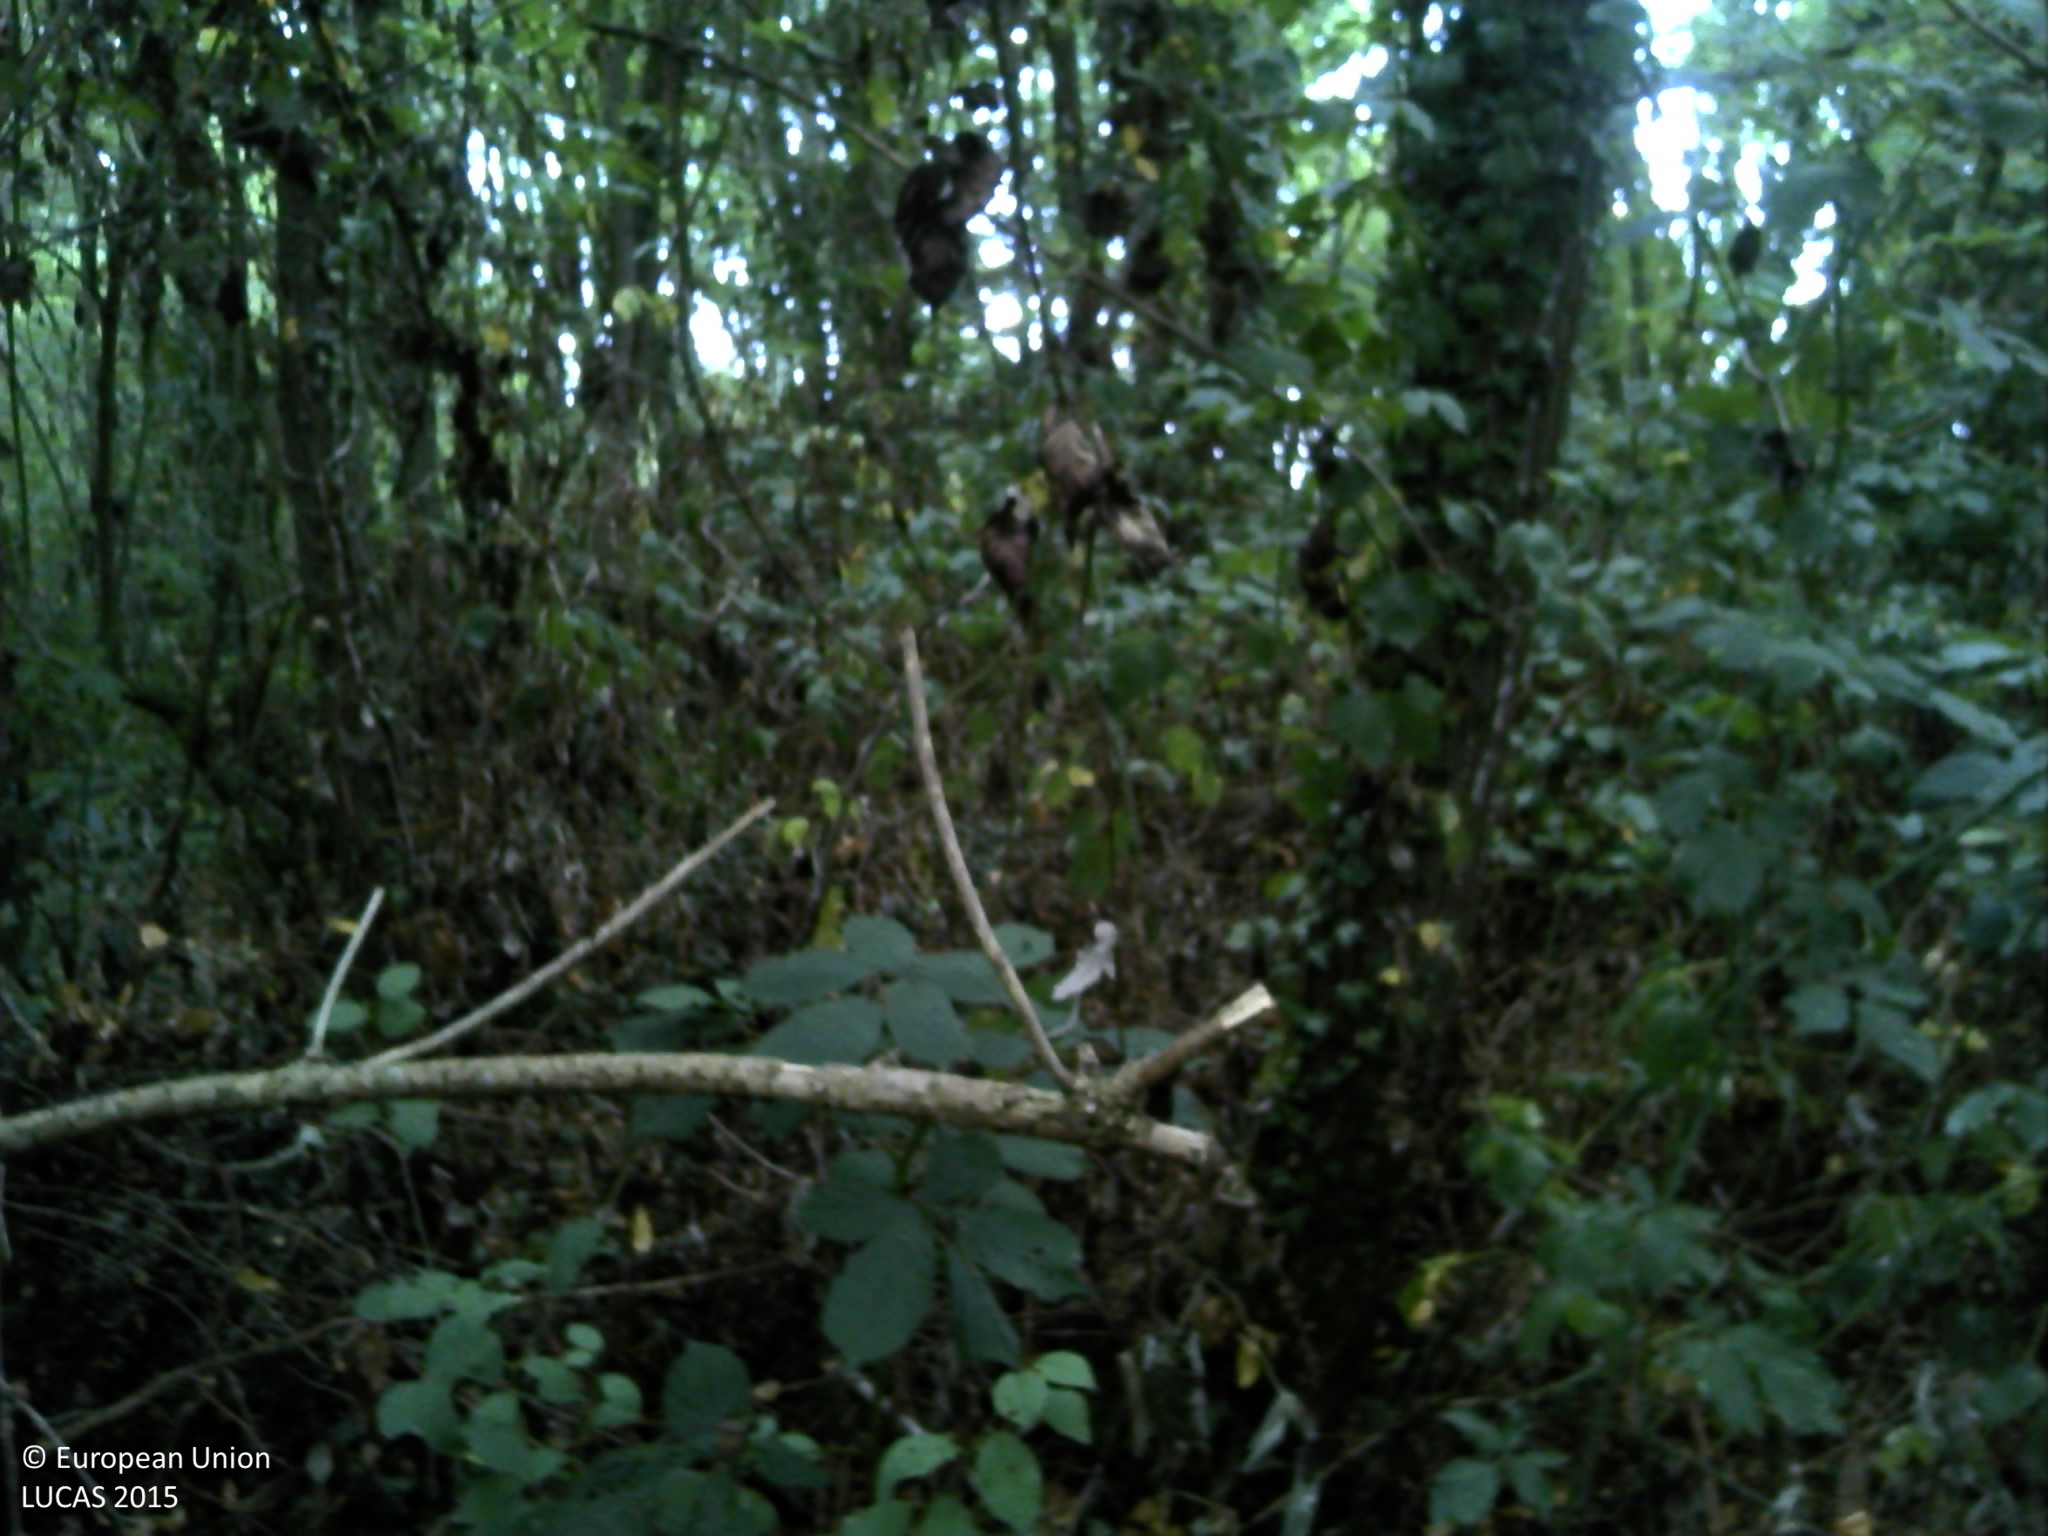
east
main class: Woodland
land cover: Broadleaved woodland
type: acidophilous oak and oak-birch forest
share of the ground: > 75 %
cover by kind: broadleaved forest trees 60 %, shrubs 30 %, herbaceous plants 5 %, lichens and mosses 5 %
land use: Semi-natural and natural areas not in use
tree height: > 5 m
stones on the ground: 10 - 25 %
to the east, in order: Broadleaved woodland; Pine dominated coniferous woodland; Fences; Grassland without tree/shrub cover; Fences; Grassland without tree/shrub cover; Electric lines; Grassland without tree/shrub cover; Tracks; Grassland without tree/shrub cover; Vineyards
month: July
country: FR
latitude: 44.6553
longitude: -0.4706
